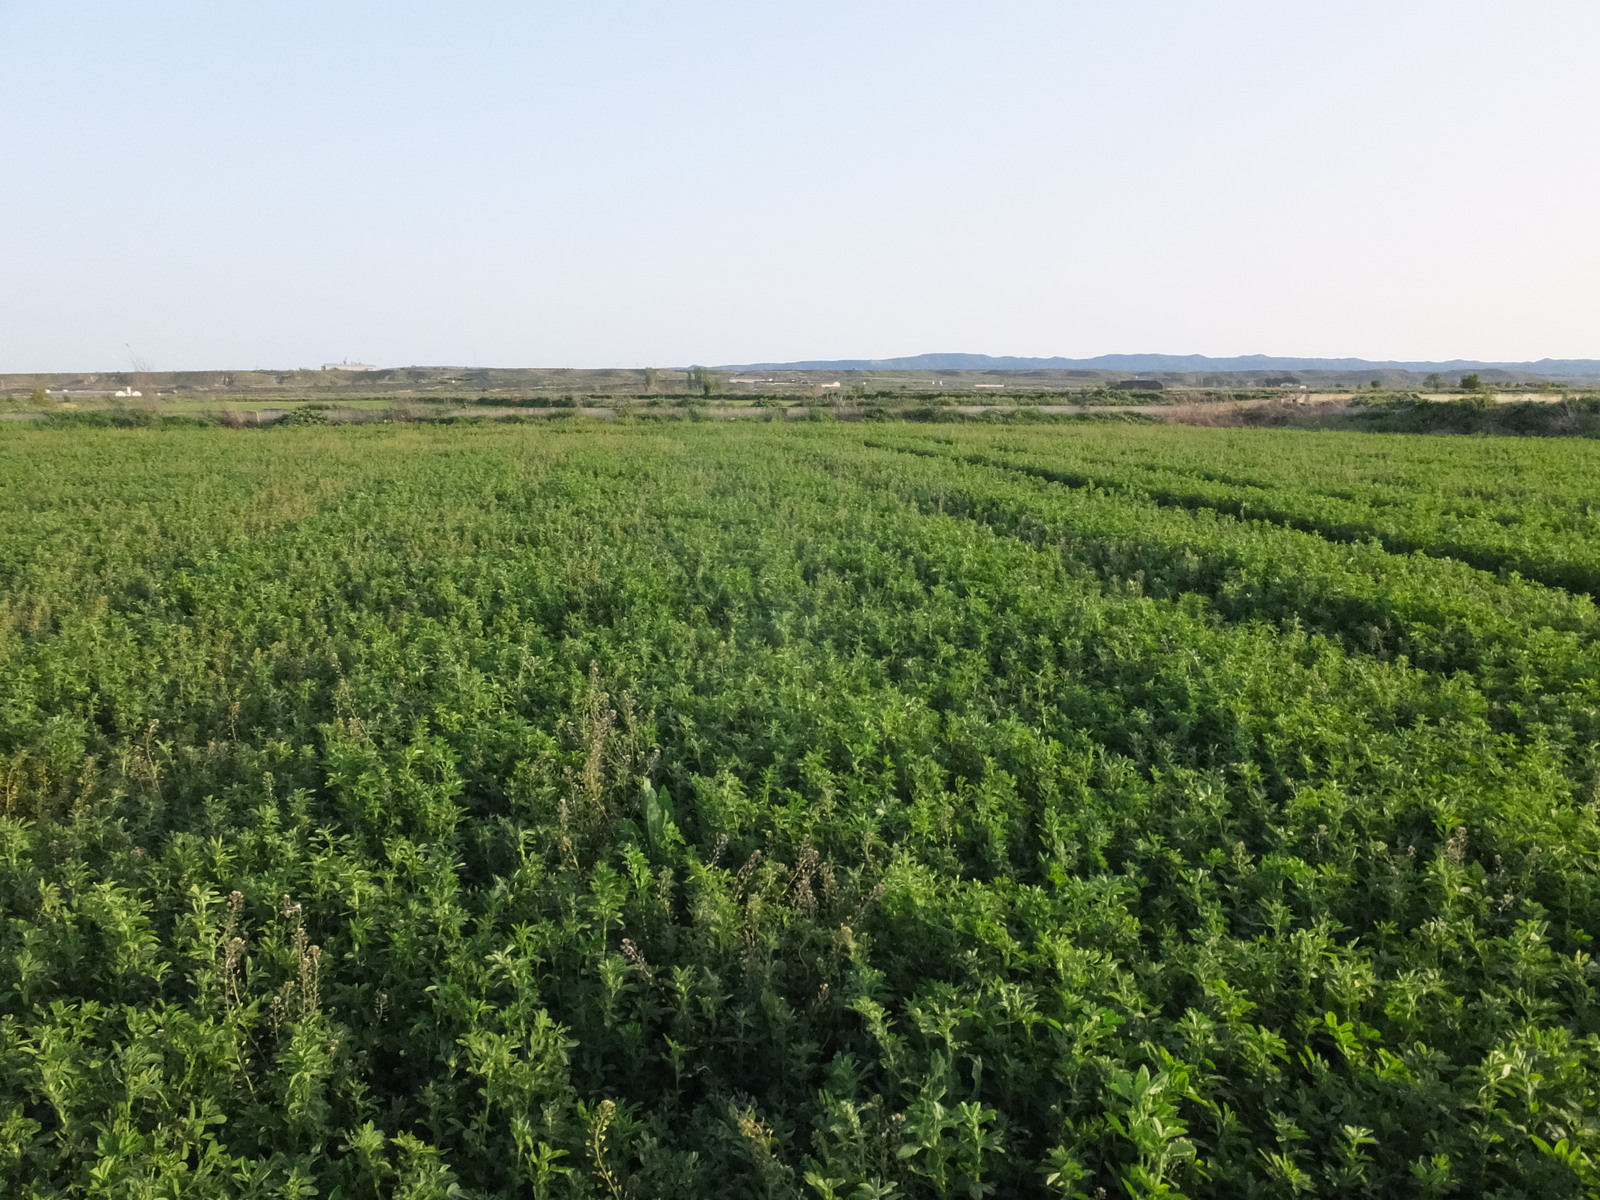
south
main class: Cropland
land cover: Lucerne
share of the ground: > 75 %
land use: Agriculture (excluding fallow land and kitchen gardens)
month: April
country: ES
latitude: 41.7966
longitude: -0.3328
